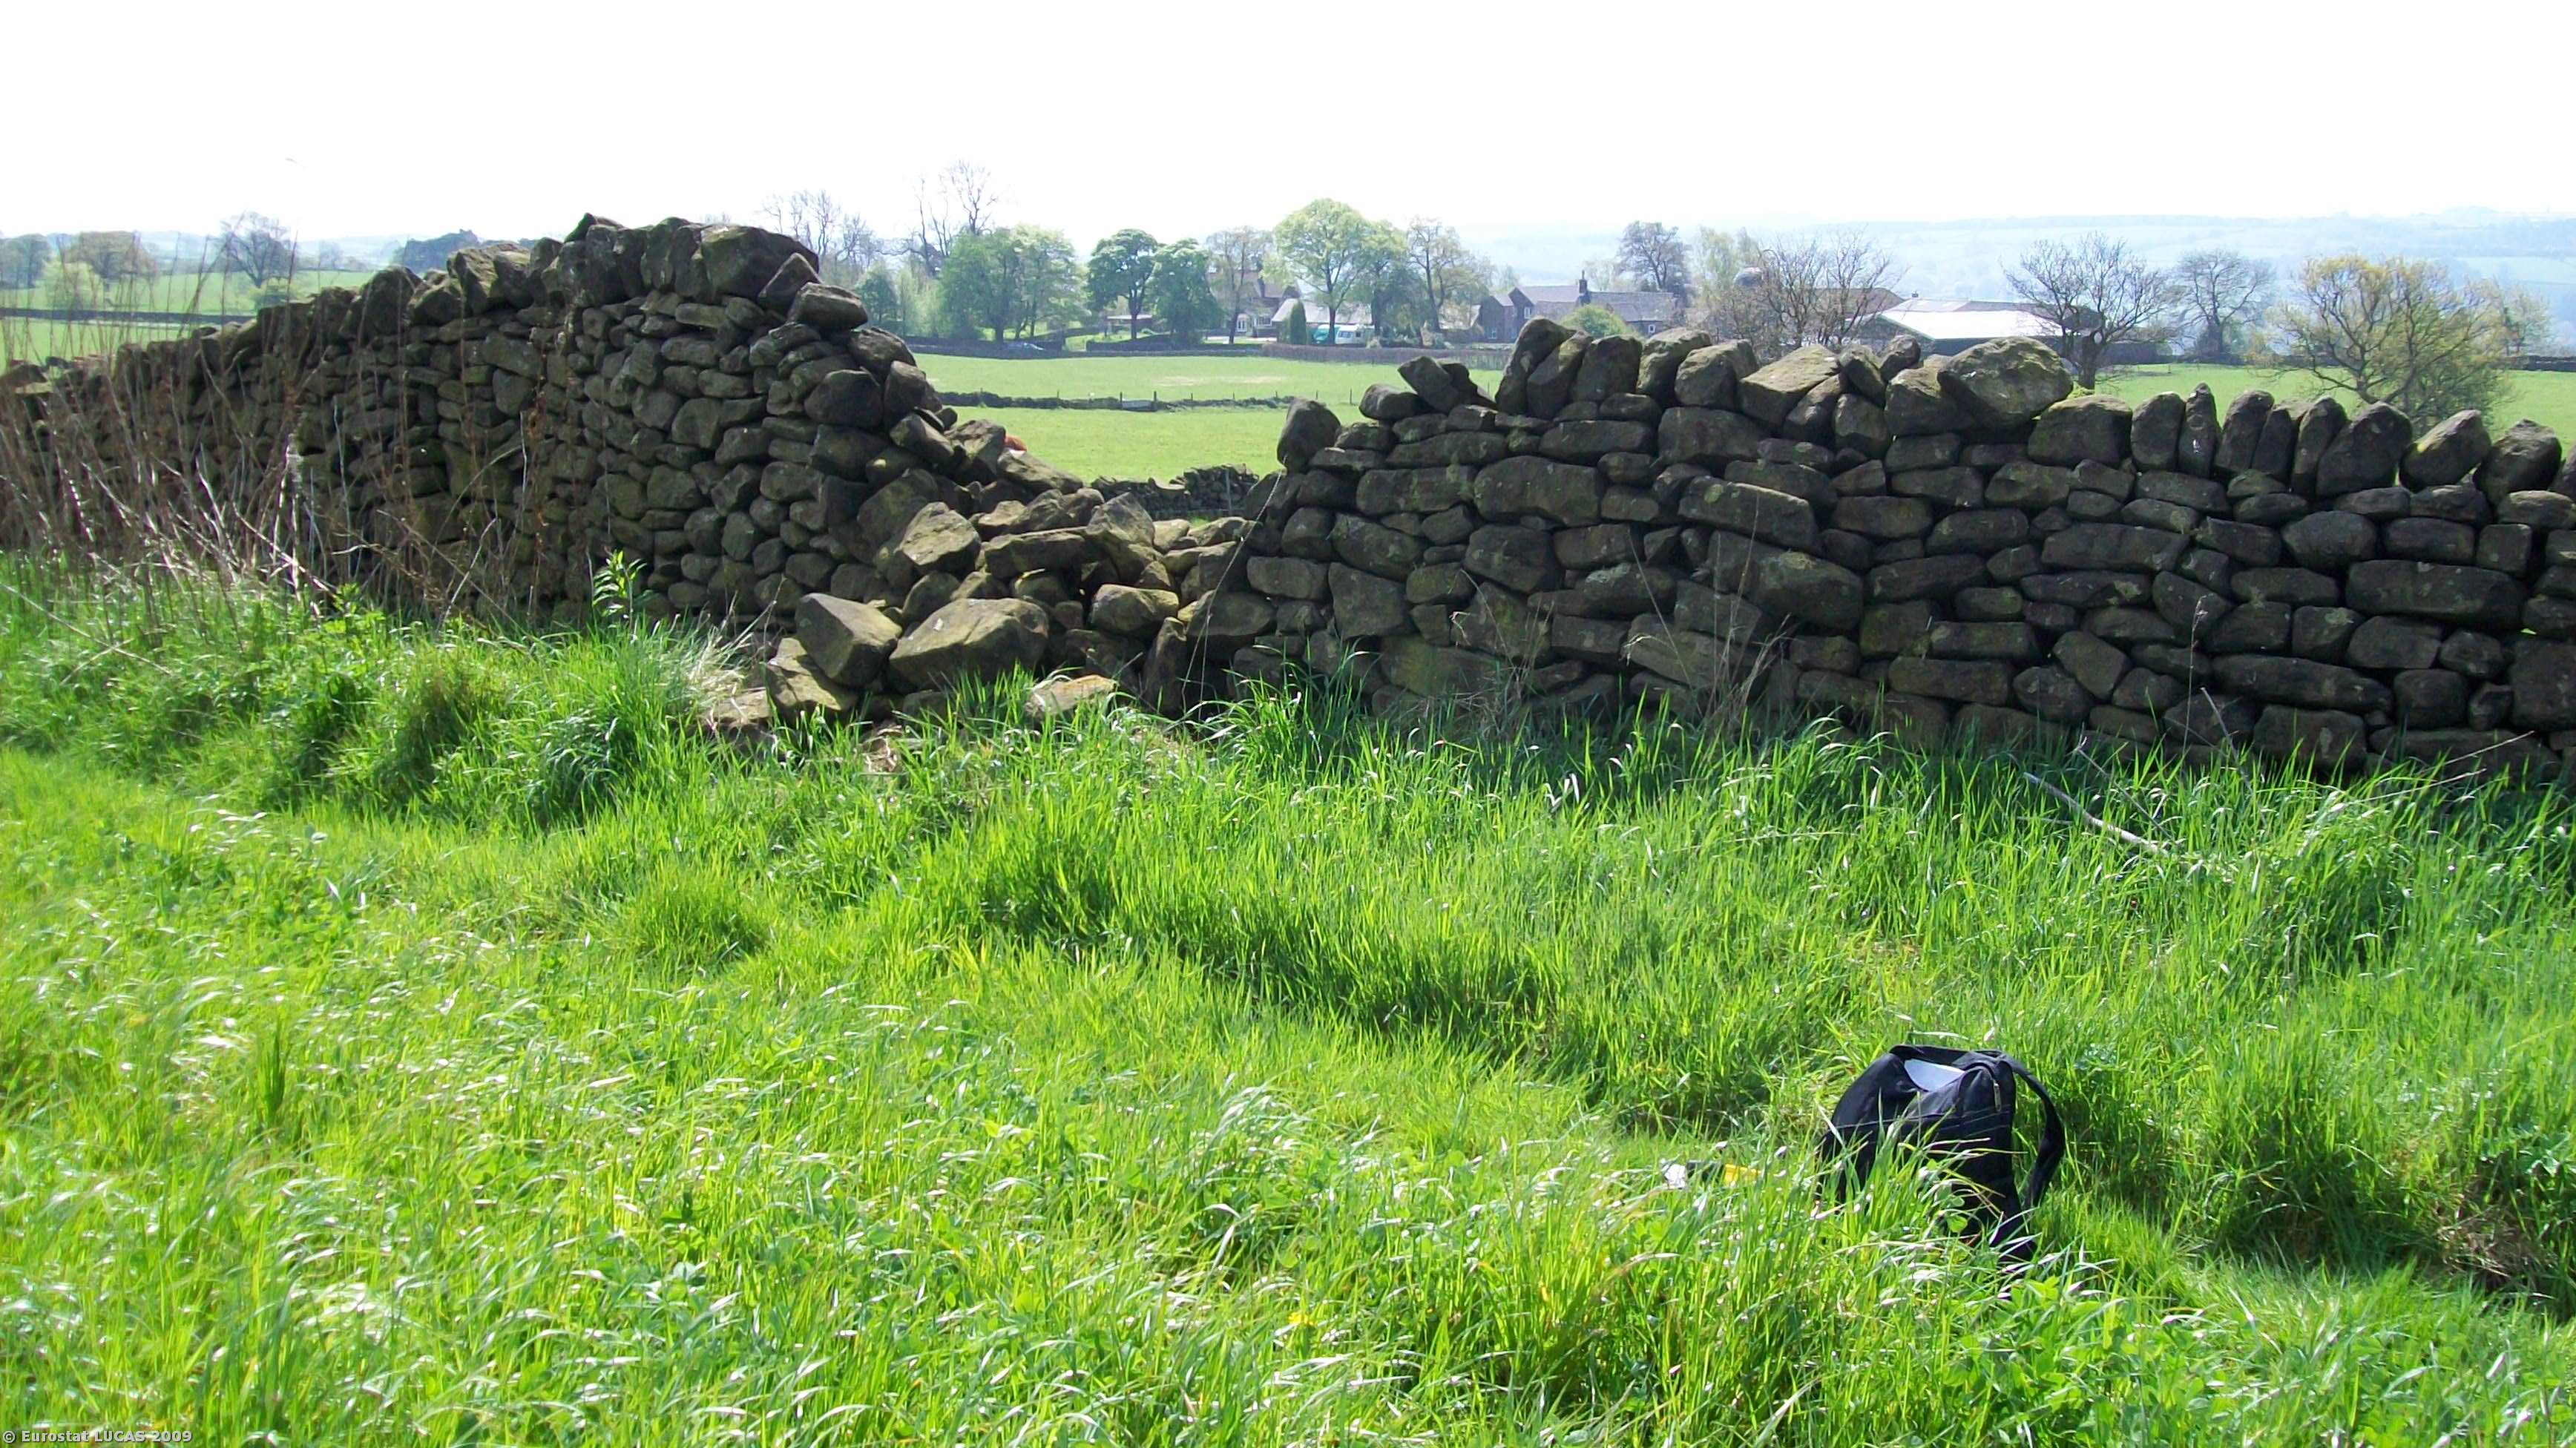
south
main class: Cropland
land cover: Clovers
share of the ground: > 75 %
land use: Agriculture (excluding fallow land and kitchen gardens)
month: April
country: GB
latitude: 53.1056
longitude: -1.5073
